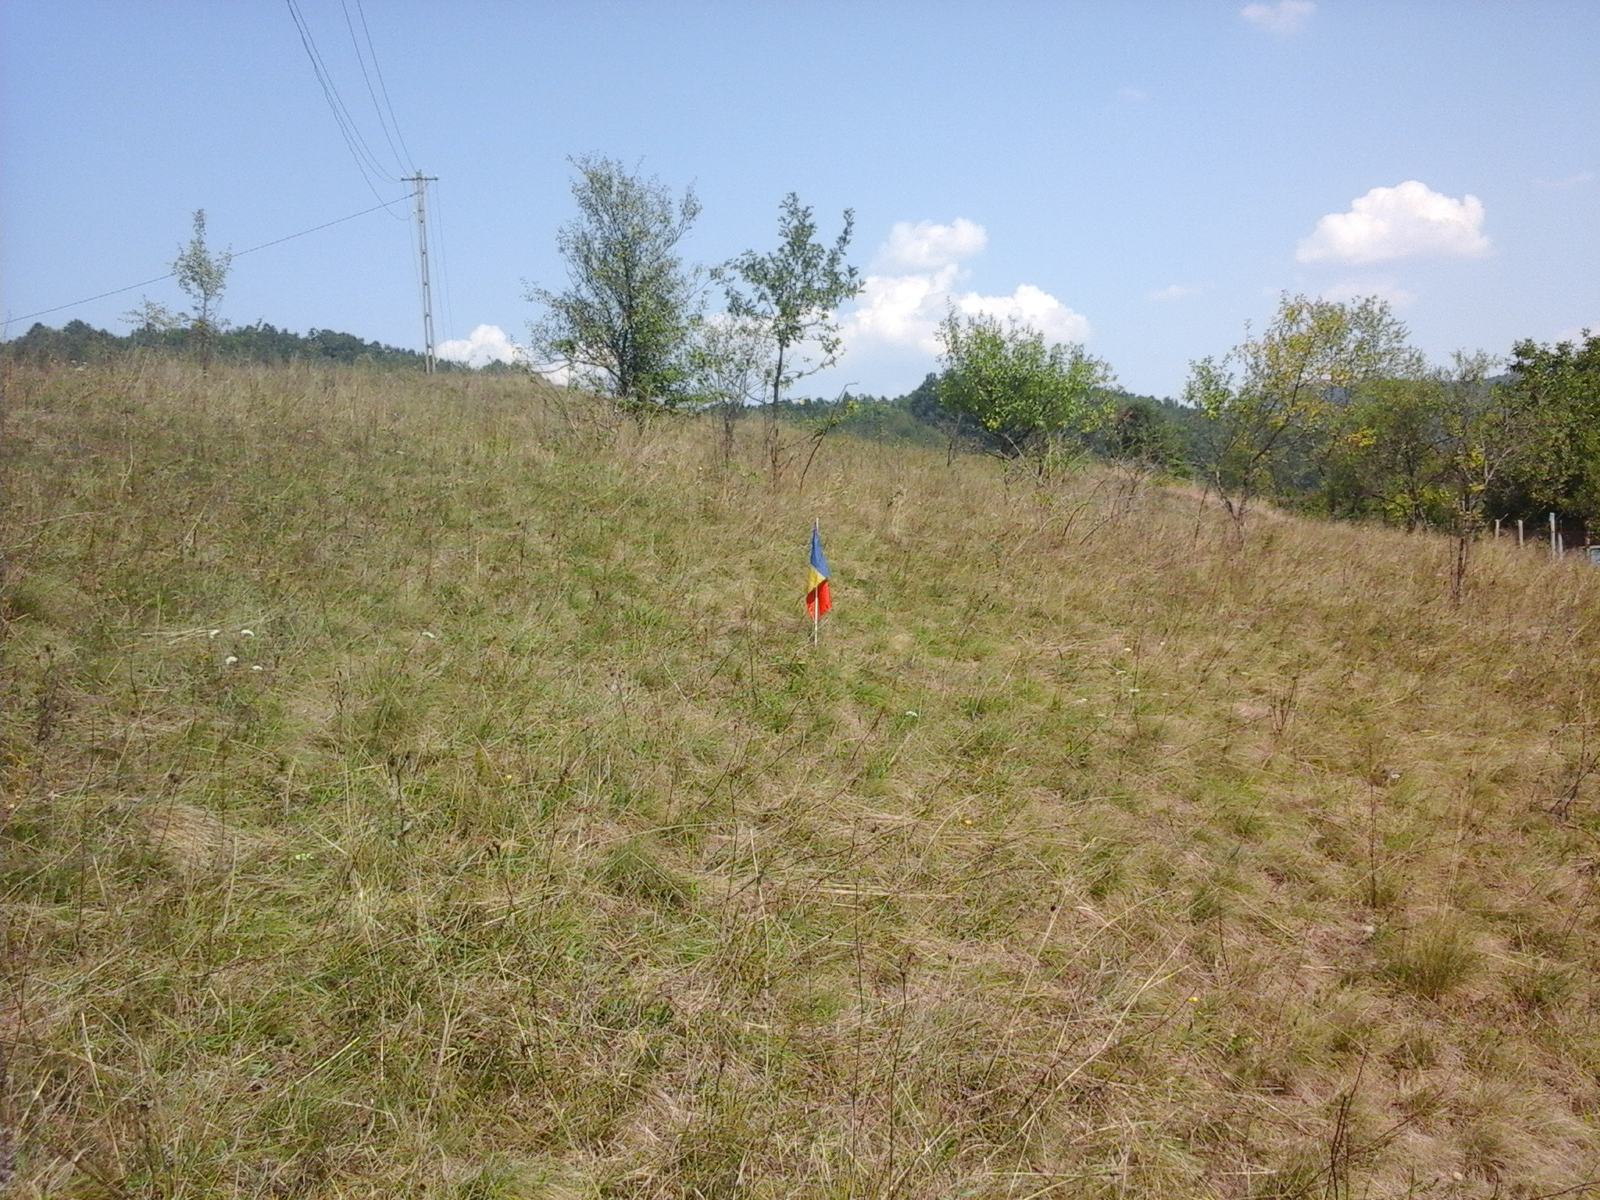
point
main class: Grassland
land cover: Grassland without tree/shrub cover
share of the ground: > 75 %
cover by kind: herbaceous plants 100 %
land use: Agriculture (excluding fallow land and kitchen gardens)
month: August
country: RO
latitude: 46.1844
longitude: 22.7630
